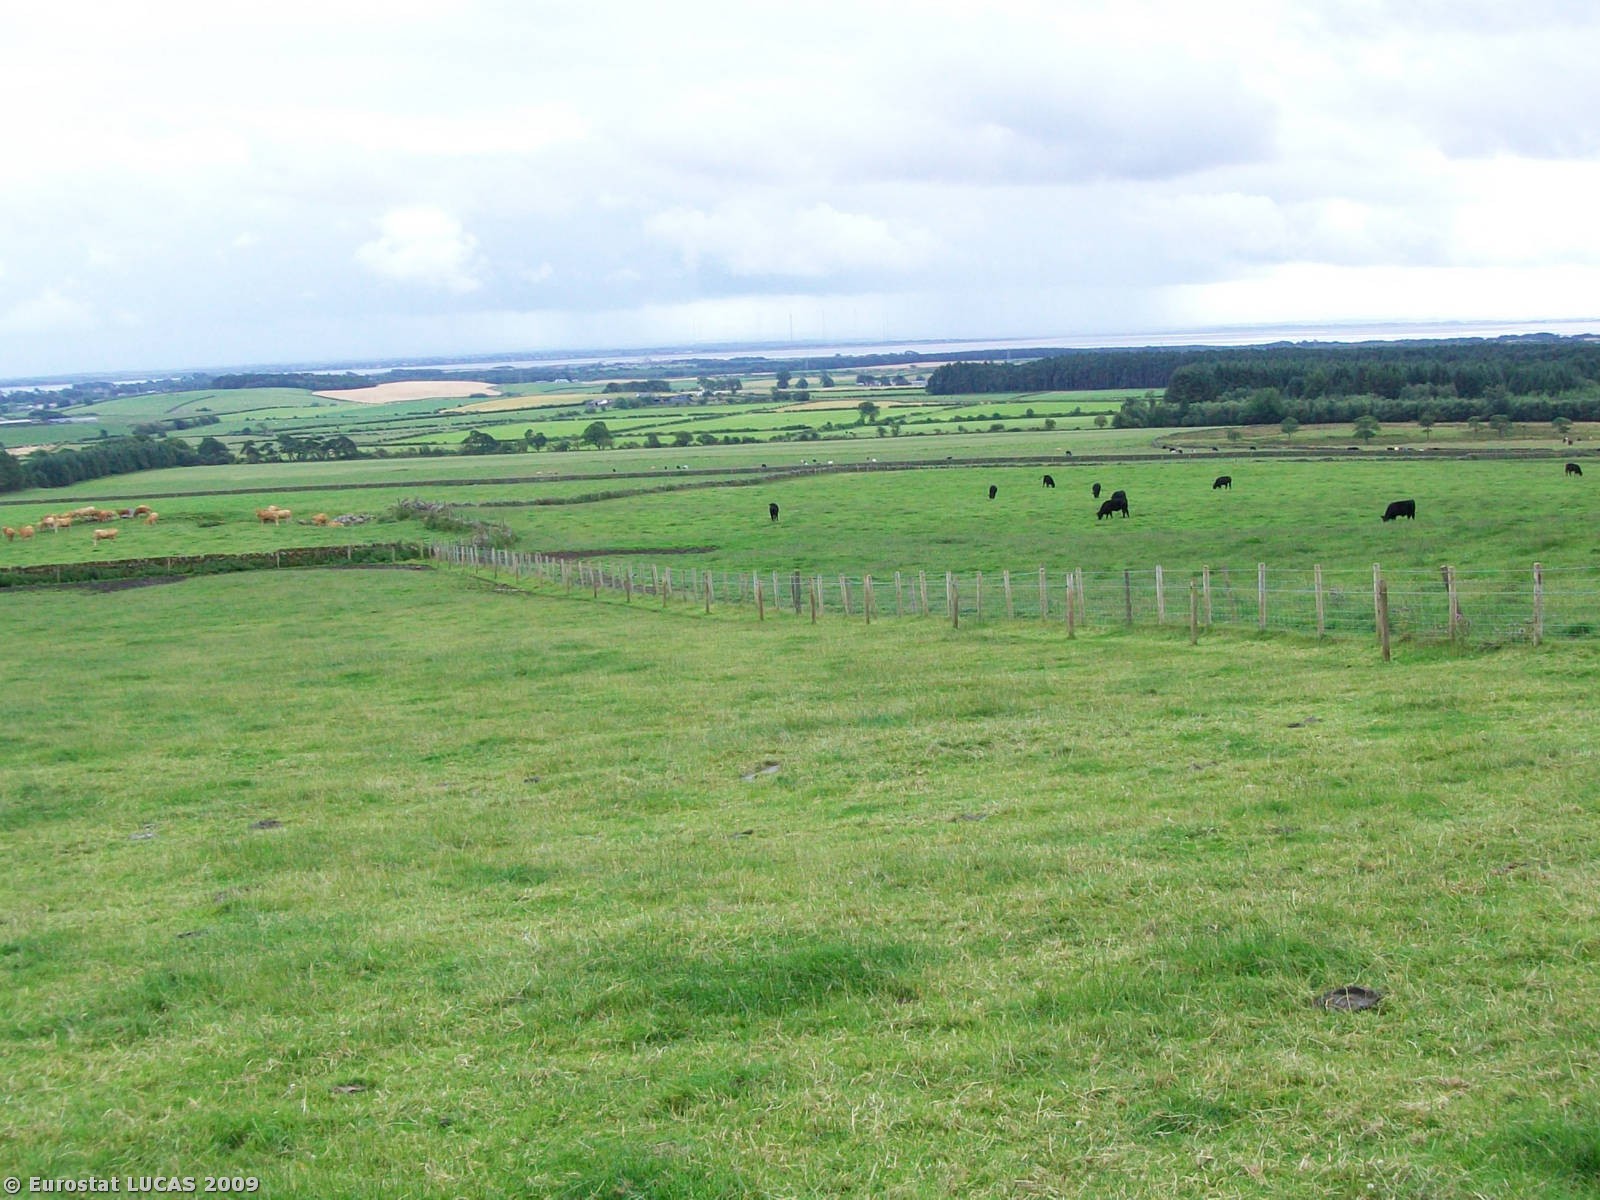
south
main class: Grassland
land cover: Grassland without tree/shrub cover
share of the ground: > 75 %
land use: Agriculture (excluding fallow land and kitchen gardens)
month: July
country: GB
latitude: 55.0353
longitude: -3.2981
